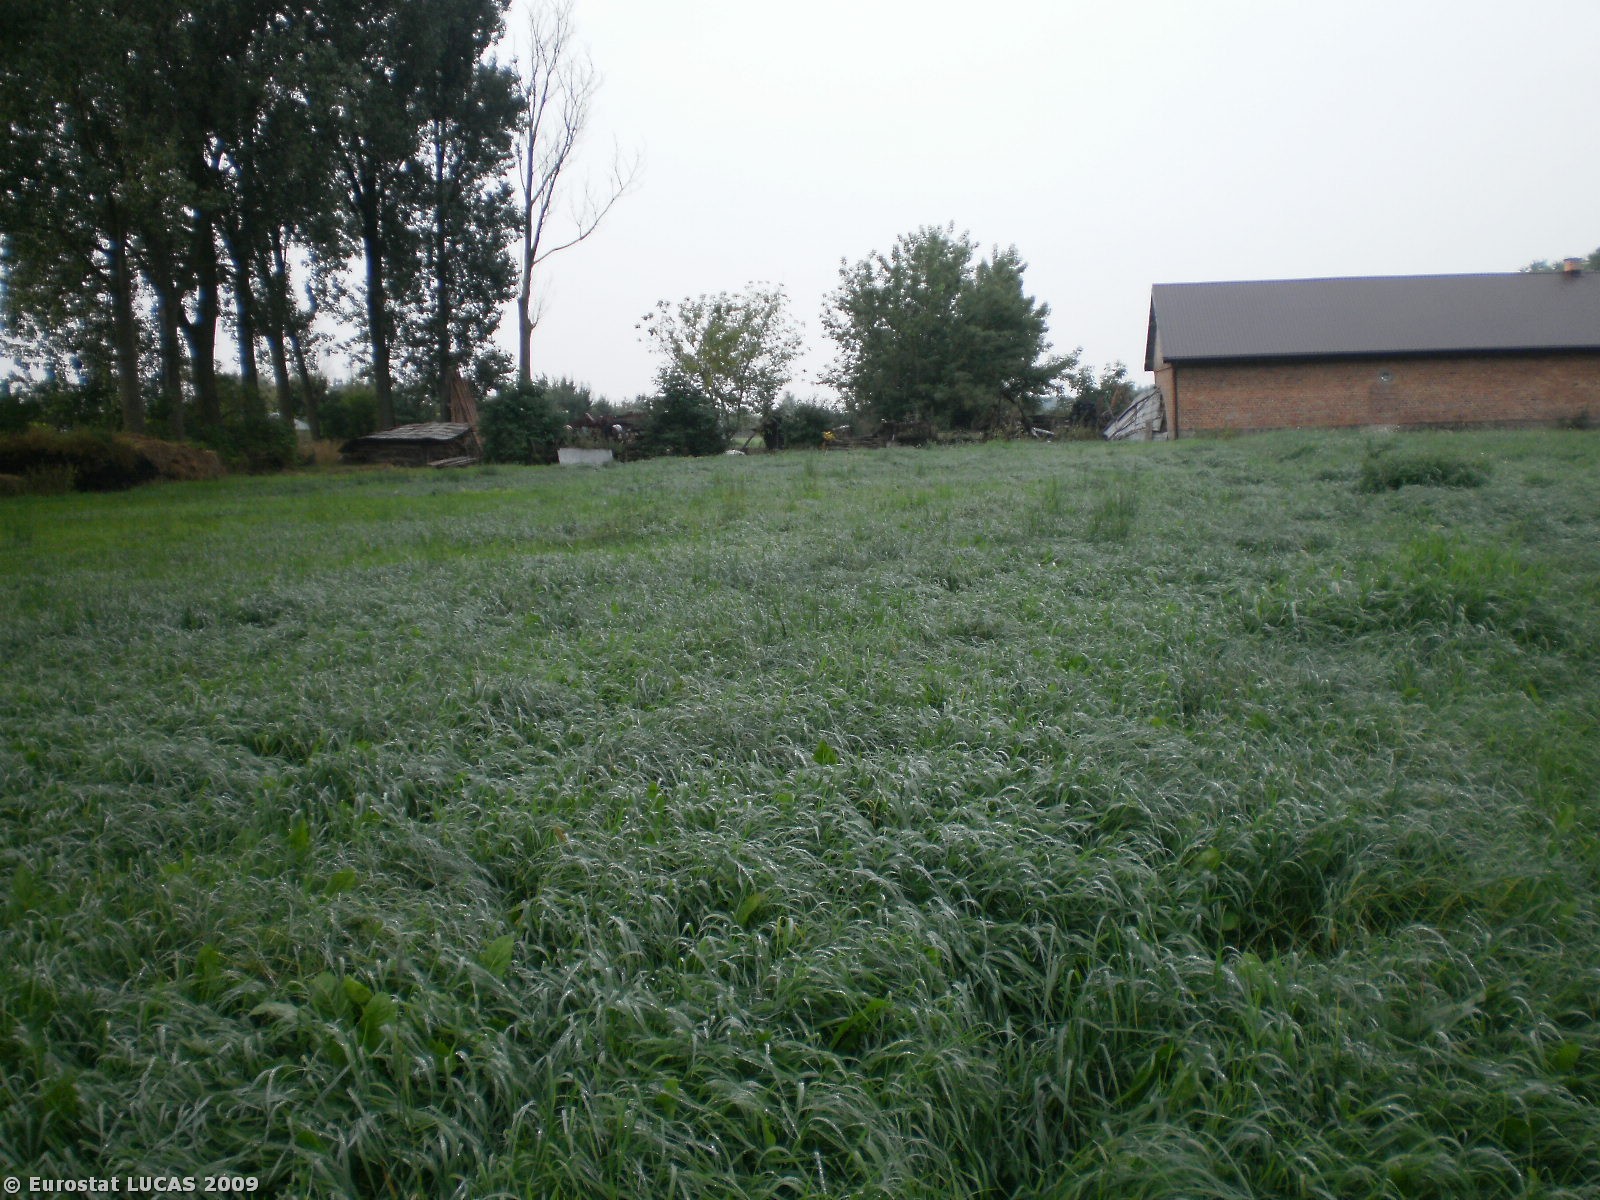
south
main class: Grassland
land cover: Grassland without tree/shrub cover
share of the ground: > 75 %
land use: Agriculture (excluding fallow land and kitchen gardens)
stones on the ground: < 10 %
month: August
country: PL
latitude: 53.0341
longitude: 20.9138
